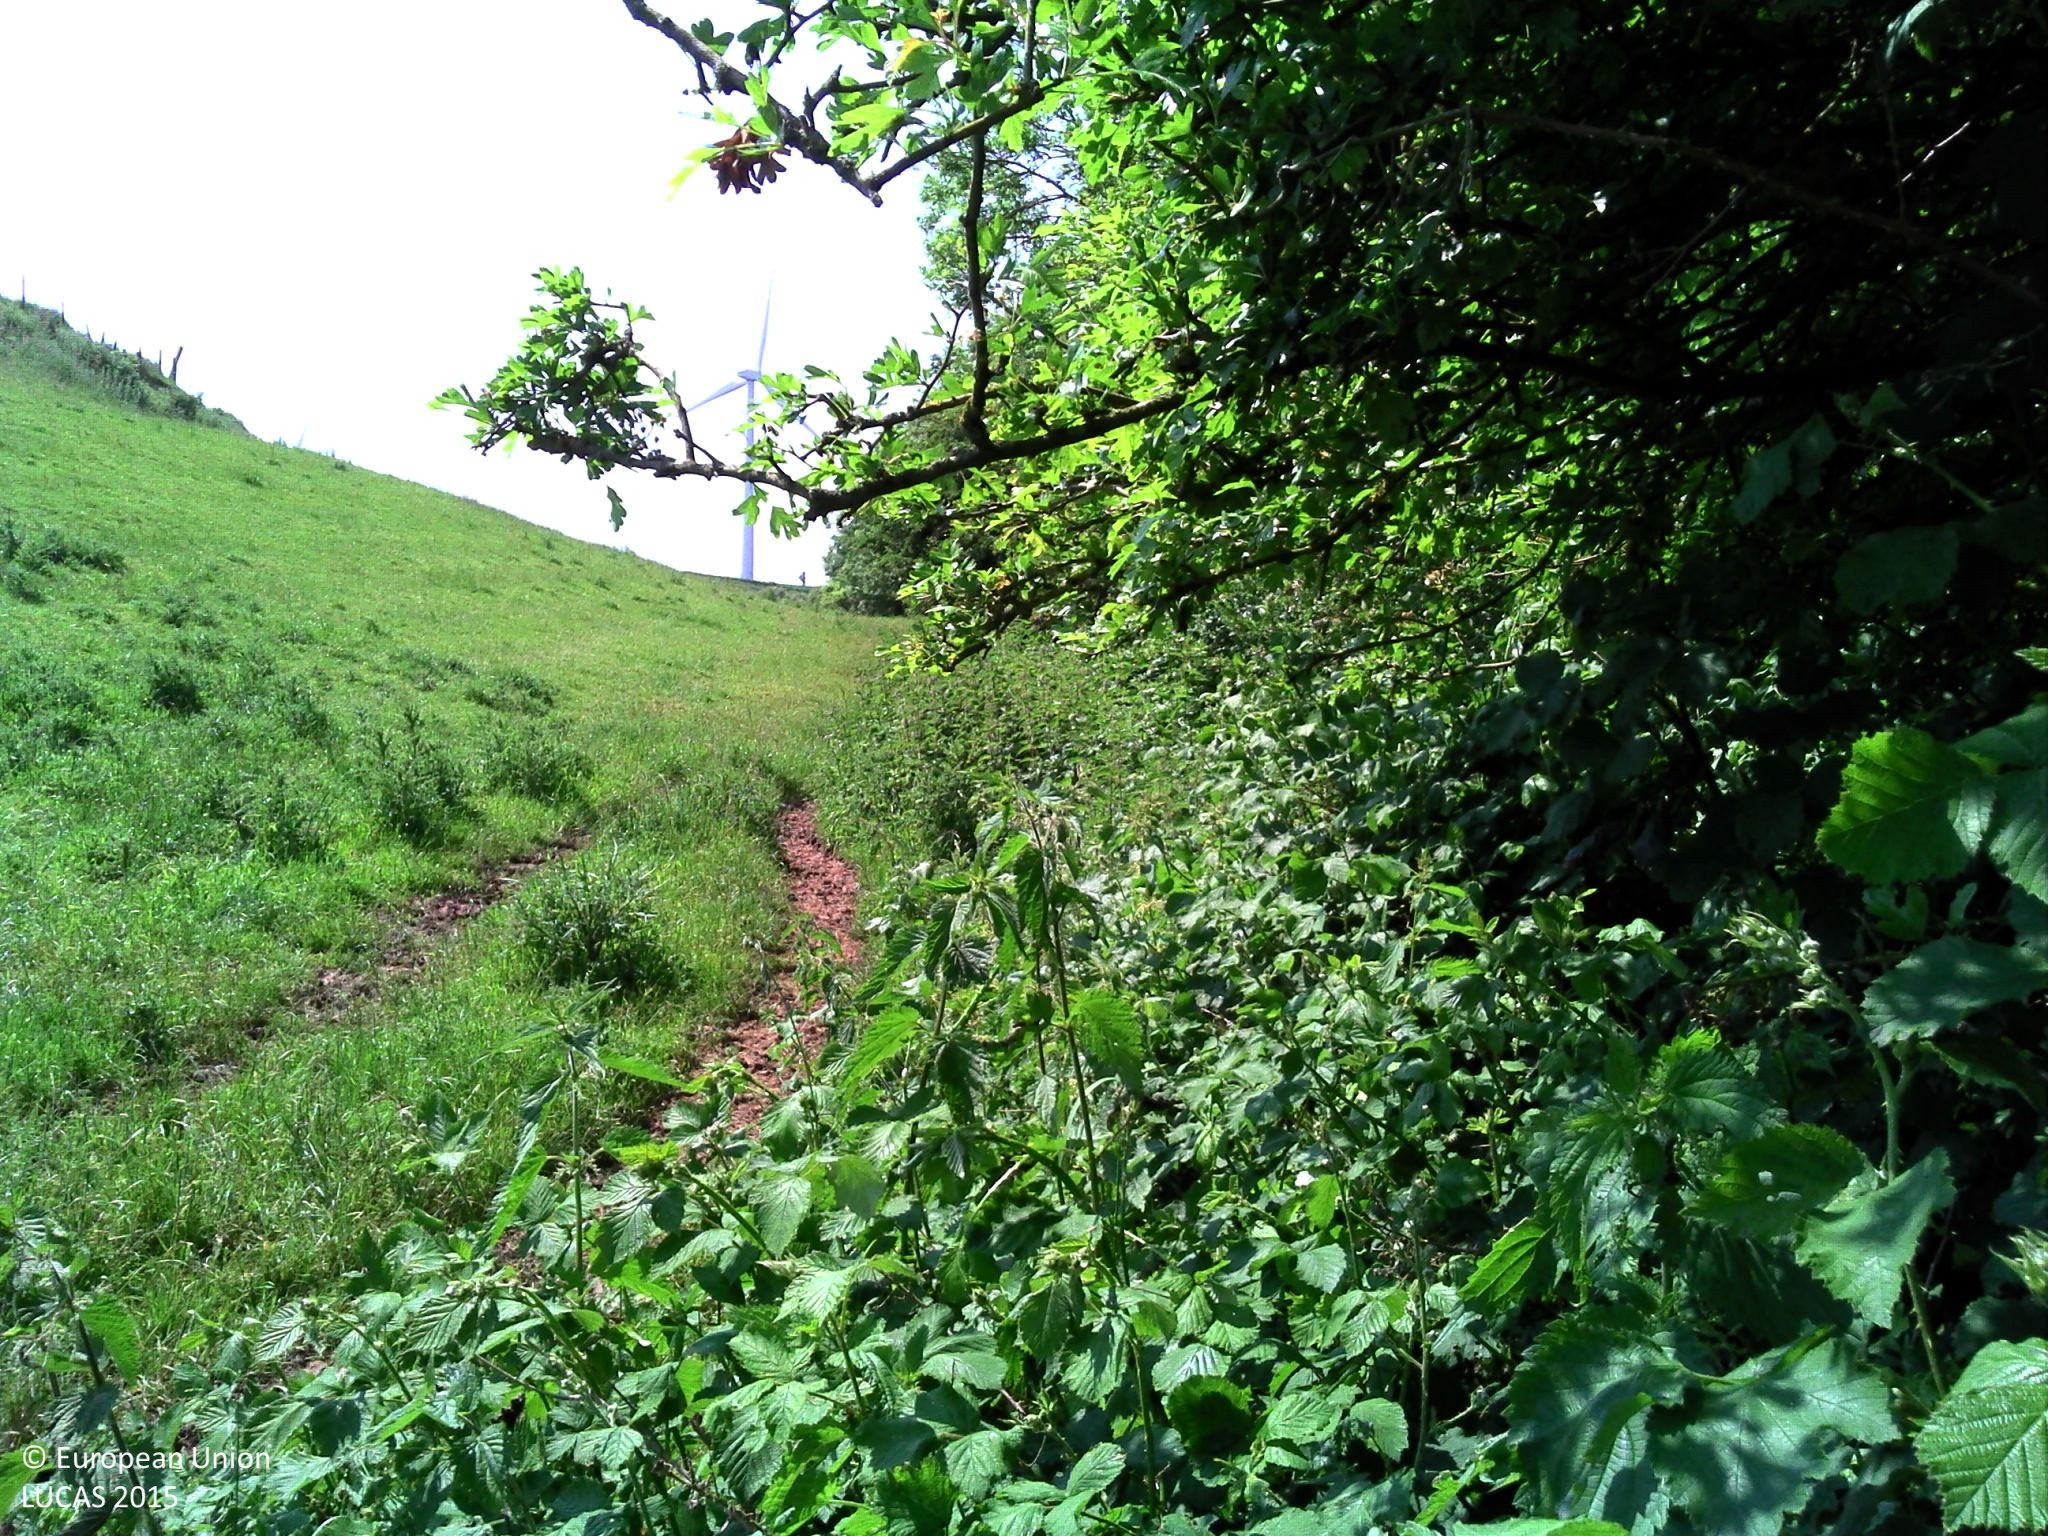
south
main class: Grassland
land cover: Grassland without tree/shrub cover
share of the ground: > 75 %
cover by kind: herbaceous plants 95 %
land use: Agriculture (excluding fallow land and kitchen gardens)
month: June
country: FR
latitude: 50.5778
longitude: 2.0909
